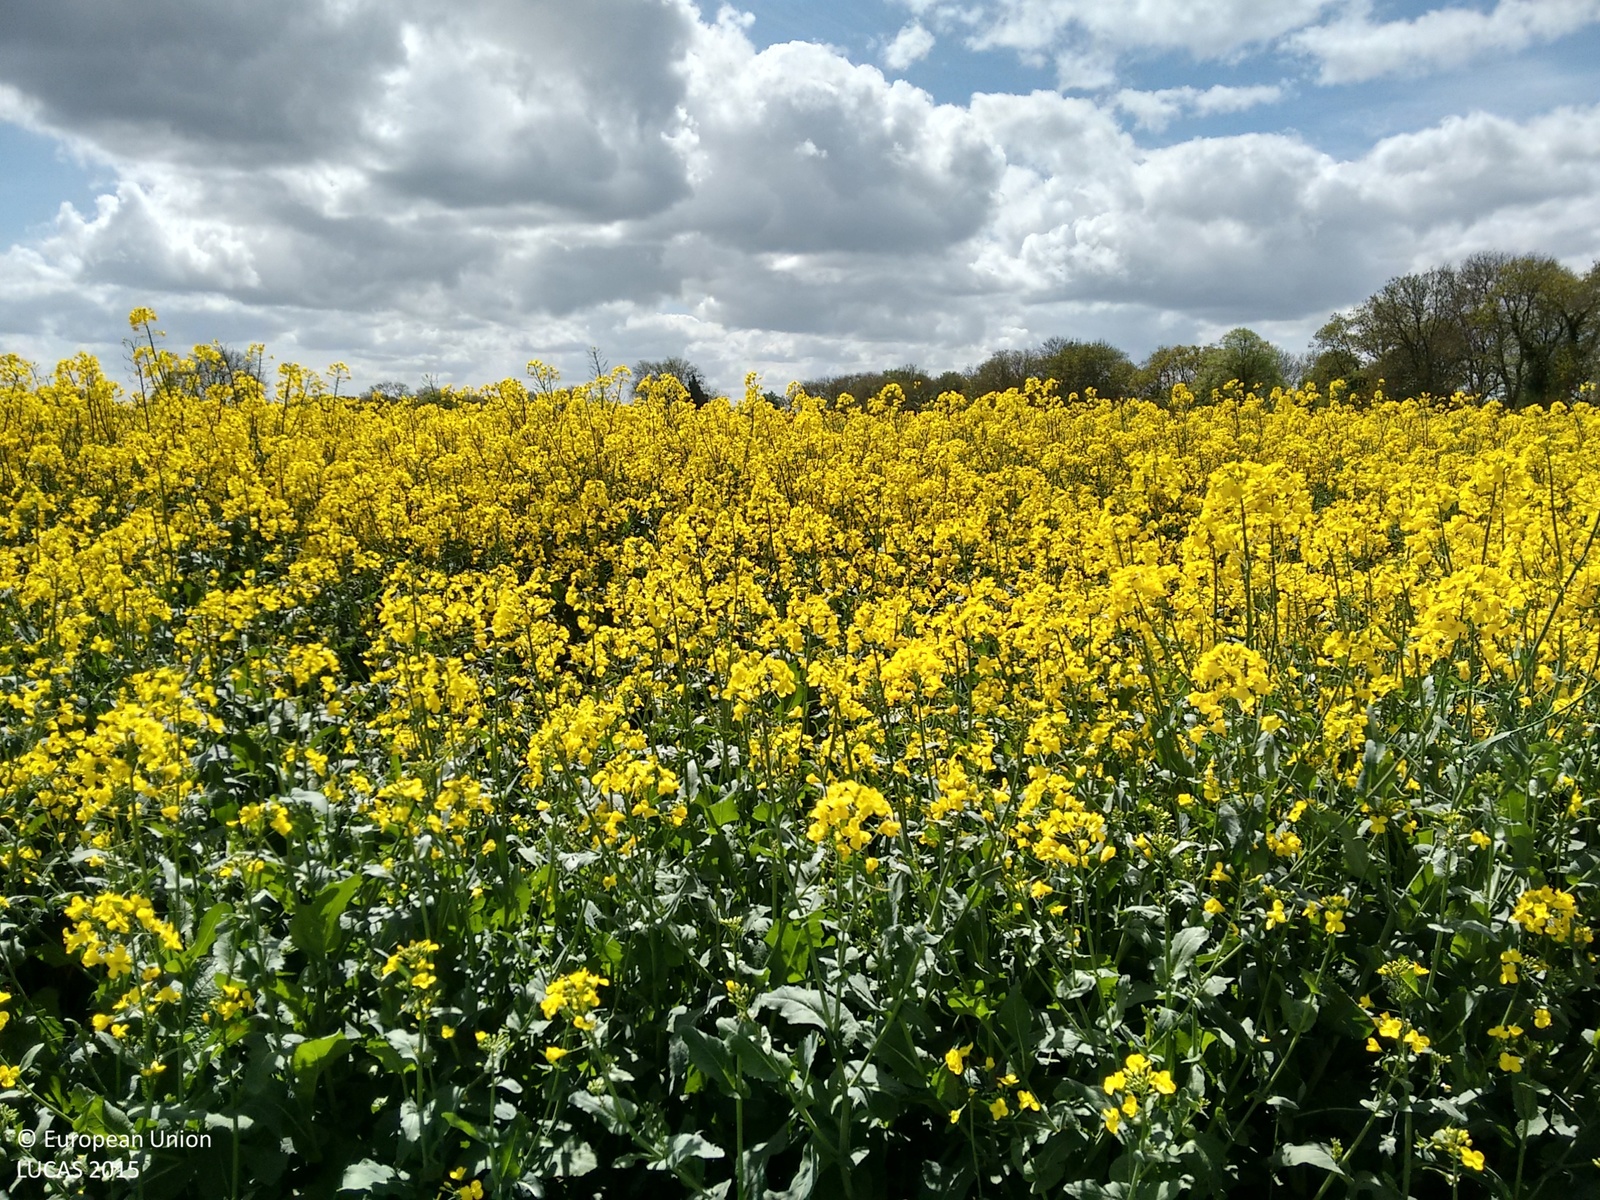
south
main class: Cropland
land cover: Rape and turnip rape
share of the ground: > 75 %
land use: Agriculture (excluding fallow land and kitchen gardens)
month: May
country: GB
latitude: 51.2683
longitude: -1.5321
